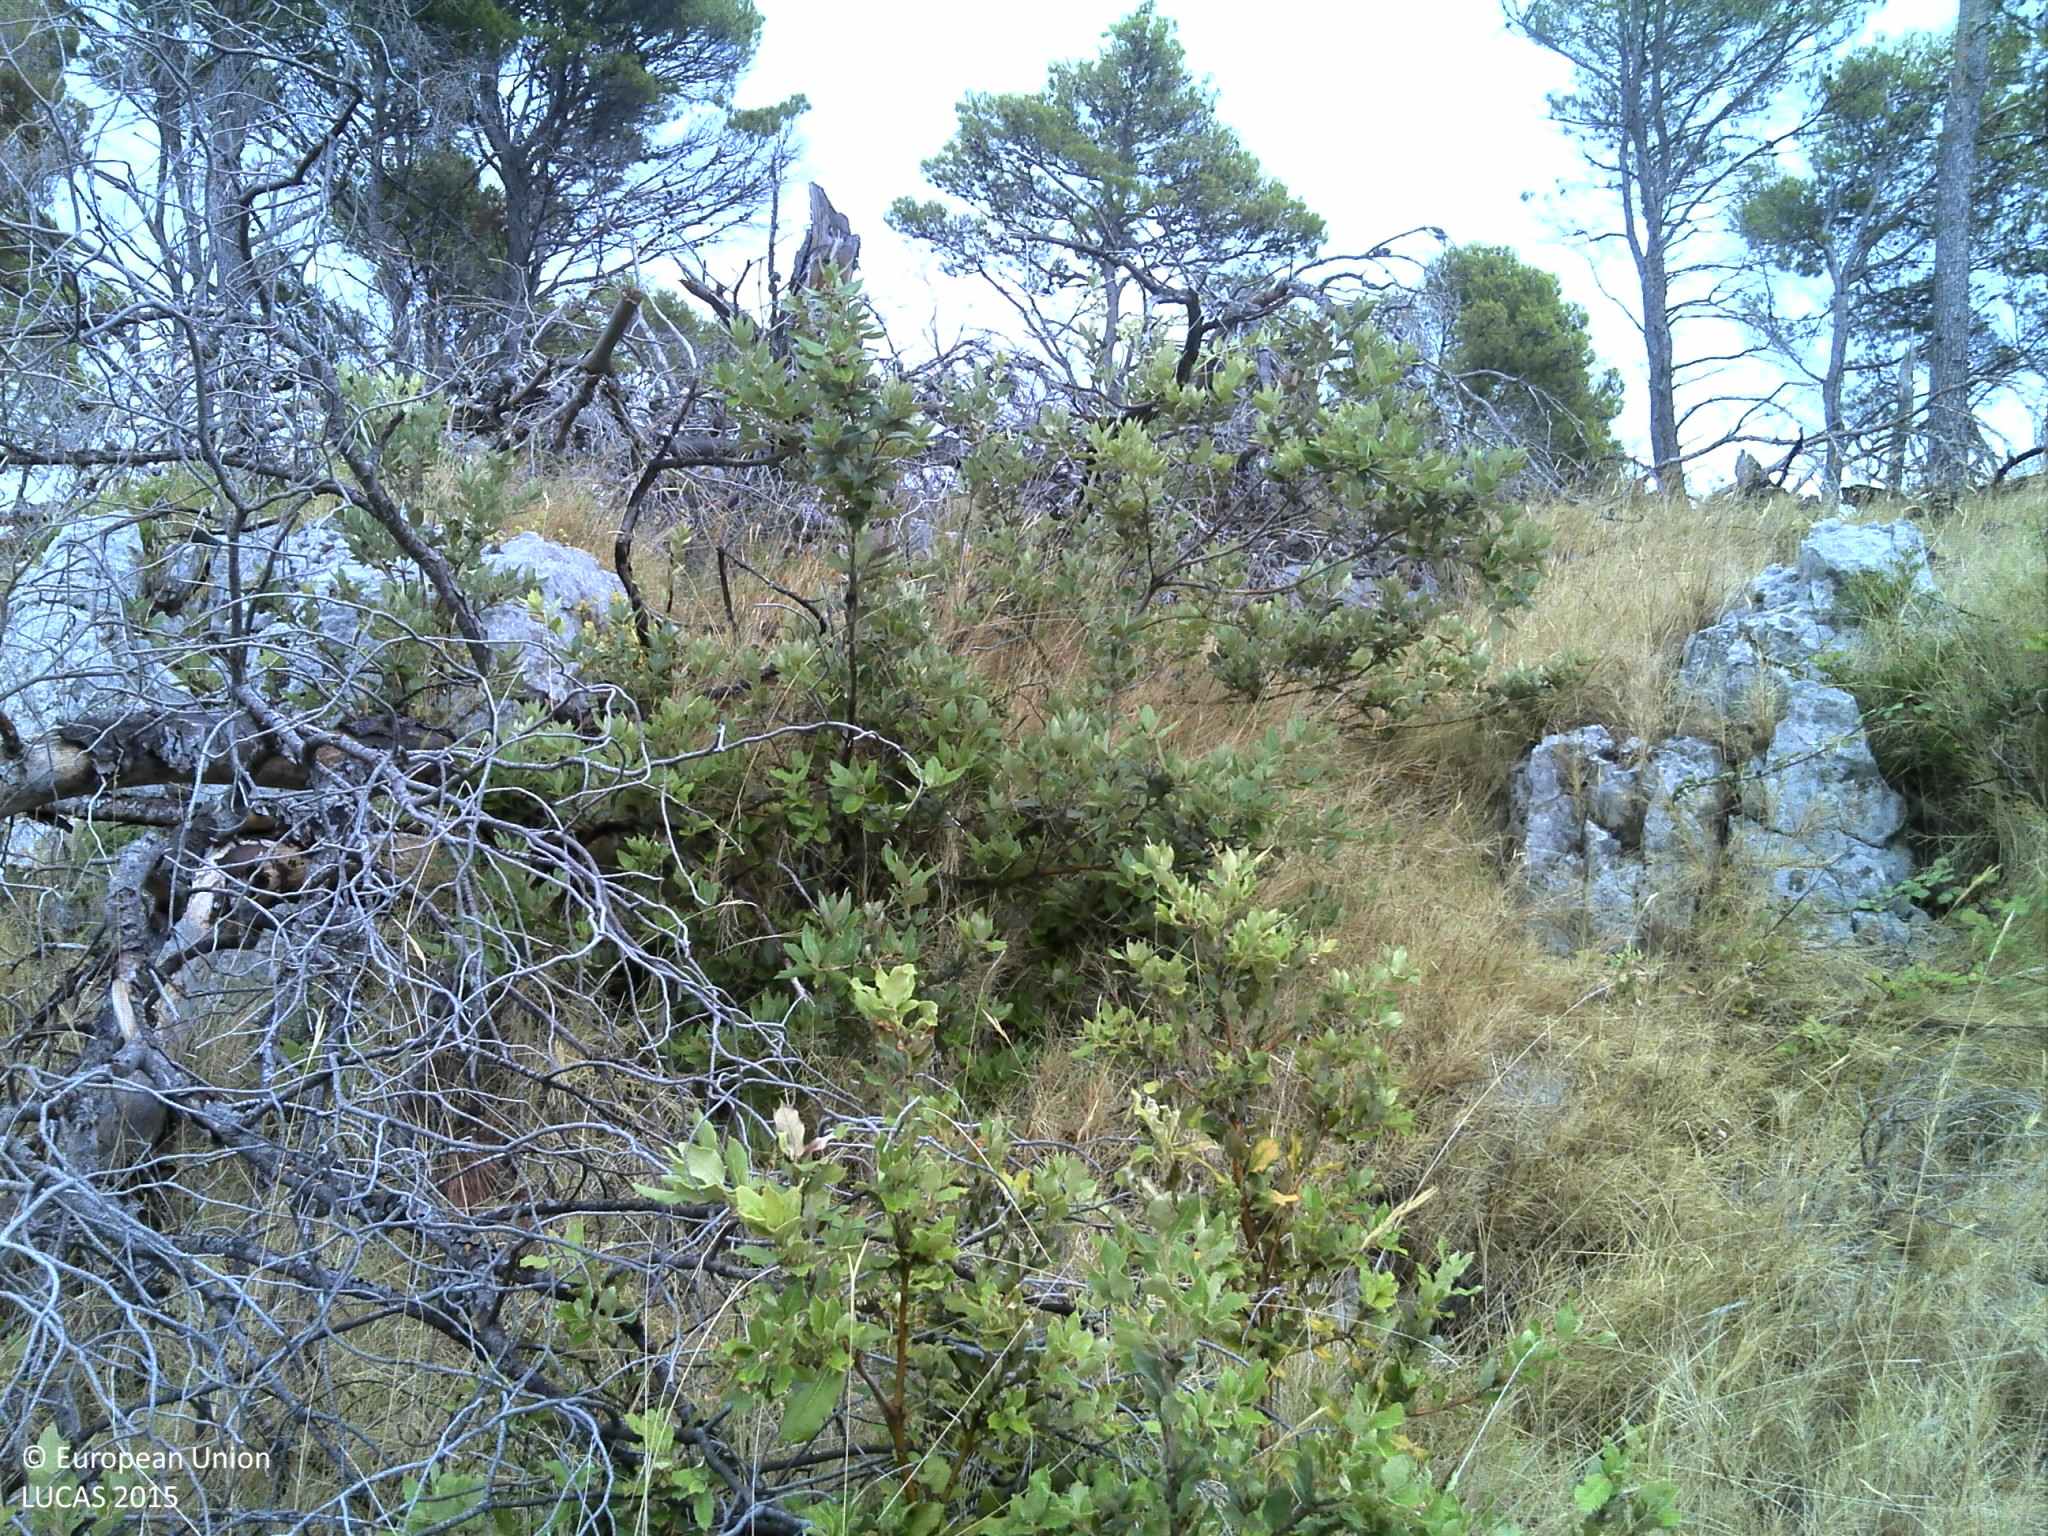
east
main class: Woodland
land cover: Pine dominated coniferous woodland
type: coniferous forest of the mediterranean region
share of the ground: 50 - 75 %
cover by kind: coniferous forest trees 50 %, shrubs 20 %, unconsolidated bare surface 15 %, herbaceous plants 10 %, consolidated bare surface 5 %
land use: Semi-natural and natural areas not in use
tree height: > 5 m
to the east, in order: Pine dominated coniferous woodland; Grassland with sparse tree/shrub cover; Pine dominated coniferous woodland; Grassland with sparse tree/shrub cover
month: July
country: HR
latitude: 43.2971
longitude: 16.4859
